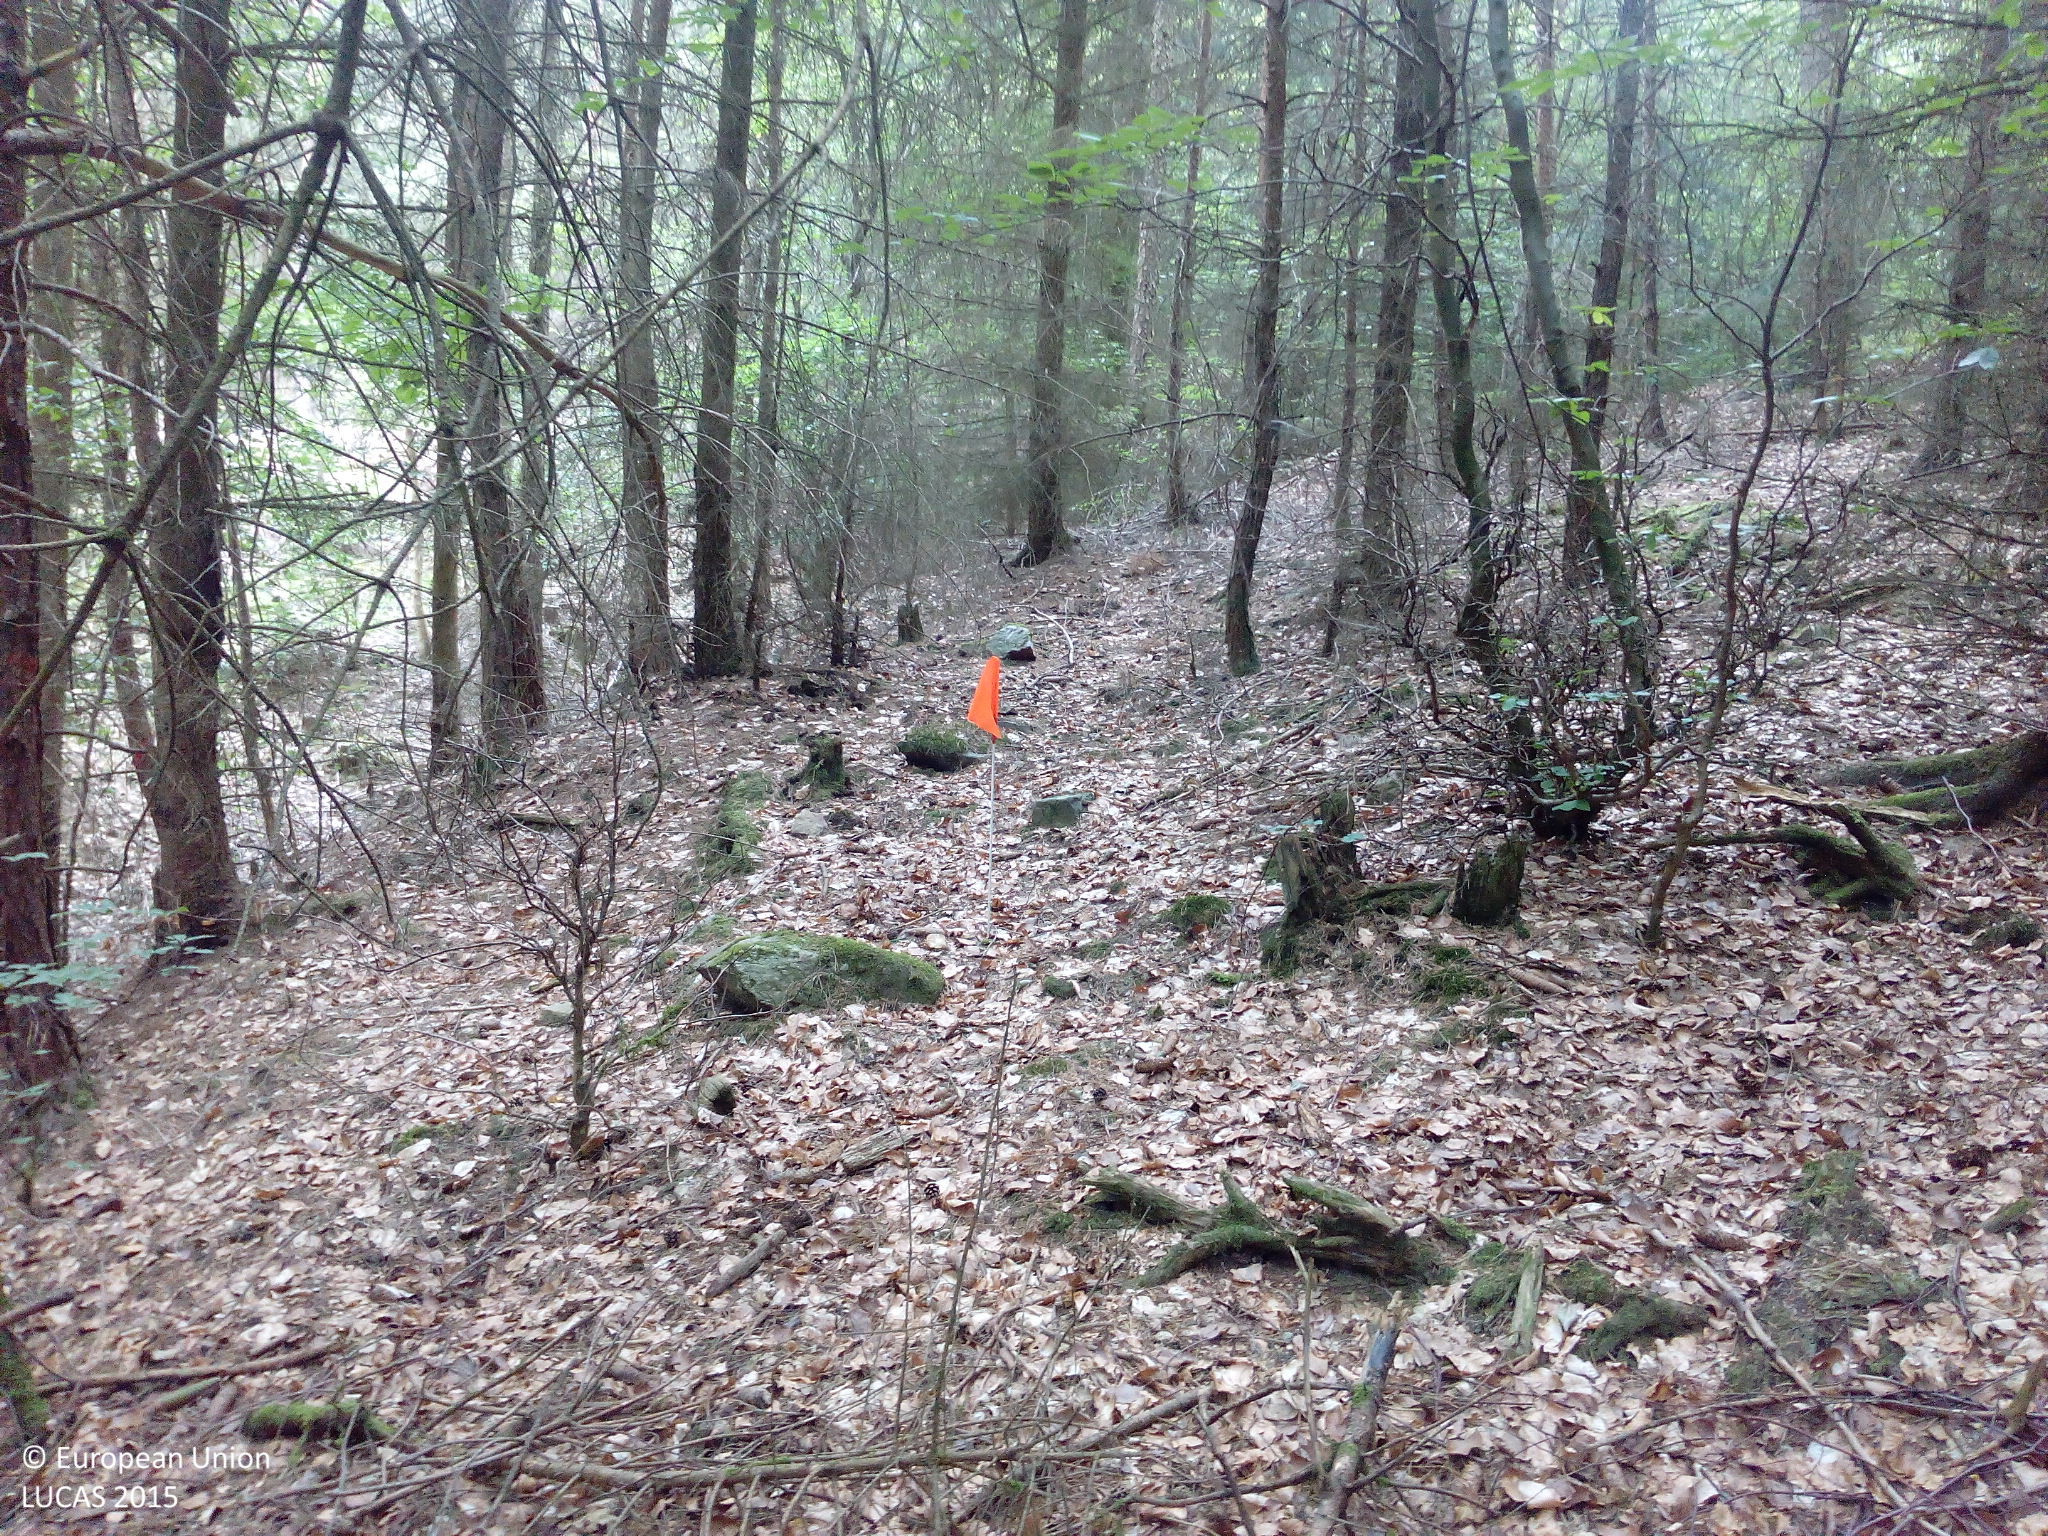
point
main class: Woodland
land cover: Other mixed woodland
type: hemiboreal forest and nemoral coniferous forest and mixed broadleaved-coniferous forest
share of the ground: > 75 %
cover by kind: coniferous forest trees 55 %, broadleaved forest trees 30 %, unconsolidated bare surface 10 %, lichens and mosses 5 %
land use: Forestry
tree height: > 5 m
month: July
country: DE
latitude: 49.9058
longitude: 7.5358
